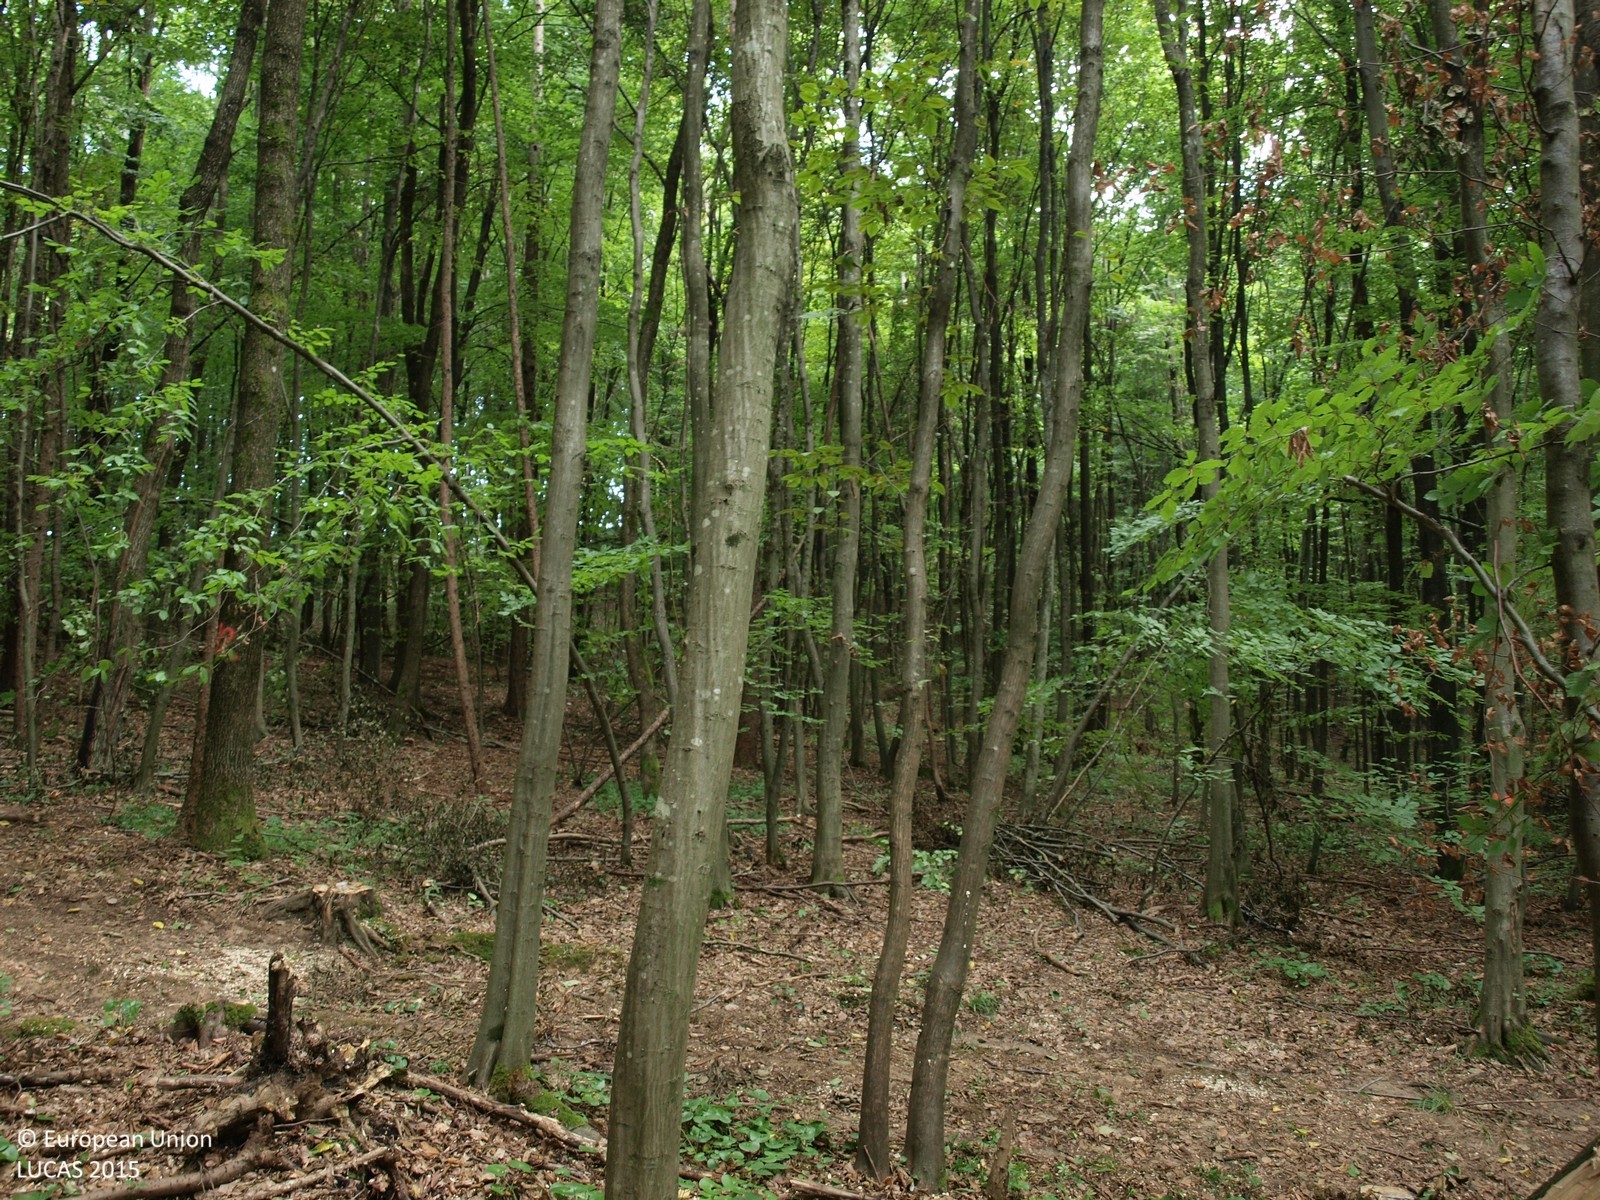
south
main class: Woodland
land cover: Broadleaved woodland
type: beech forest
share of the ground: > 75 %
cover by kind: broadleaved forest trees 100 %
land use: Forestry
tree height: > 5 m
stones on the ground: < 10 %
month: August
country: HR
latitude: 46.0028
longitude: 16.5986
